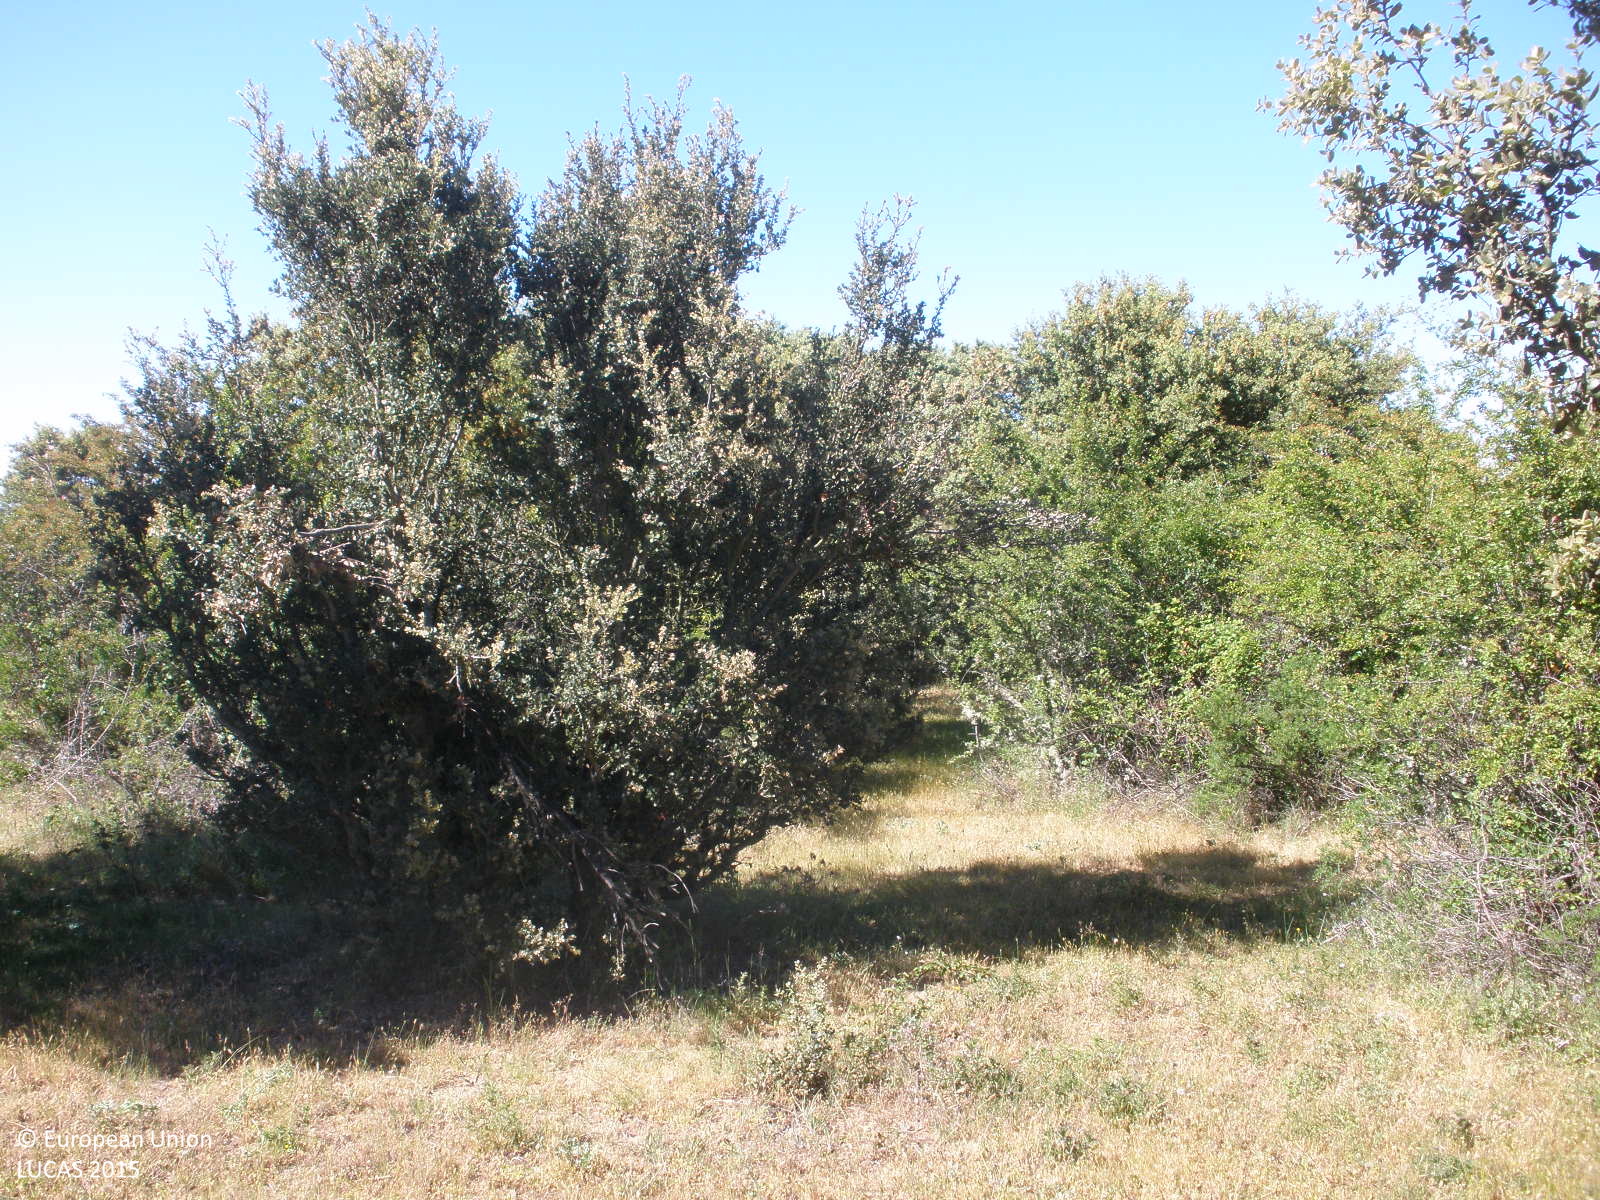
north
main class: Woodland
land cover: Broadleaved woodland
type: broadleaved evergreen forest
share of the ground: 25 - 50 %
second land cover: Grassland without tree/shrub cover
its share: > 75 %
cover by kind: herbaceous plants 50 %, broadleaved forest trees 30 %, shrubs 20 %
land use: Forestry
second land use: Agriculture (excluding fallow land and kitchen gardens)
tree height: < 5 m
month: May
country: ES
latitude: 40.7333
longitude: -5.8617
